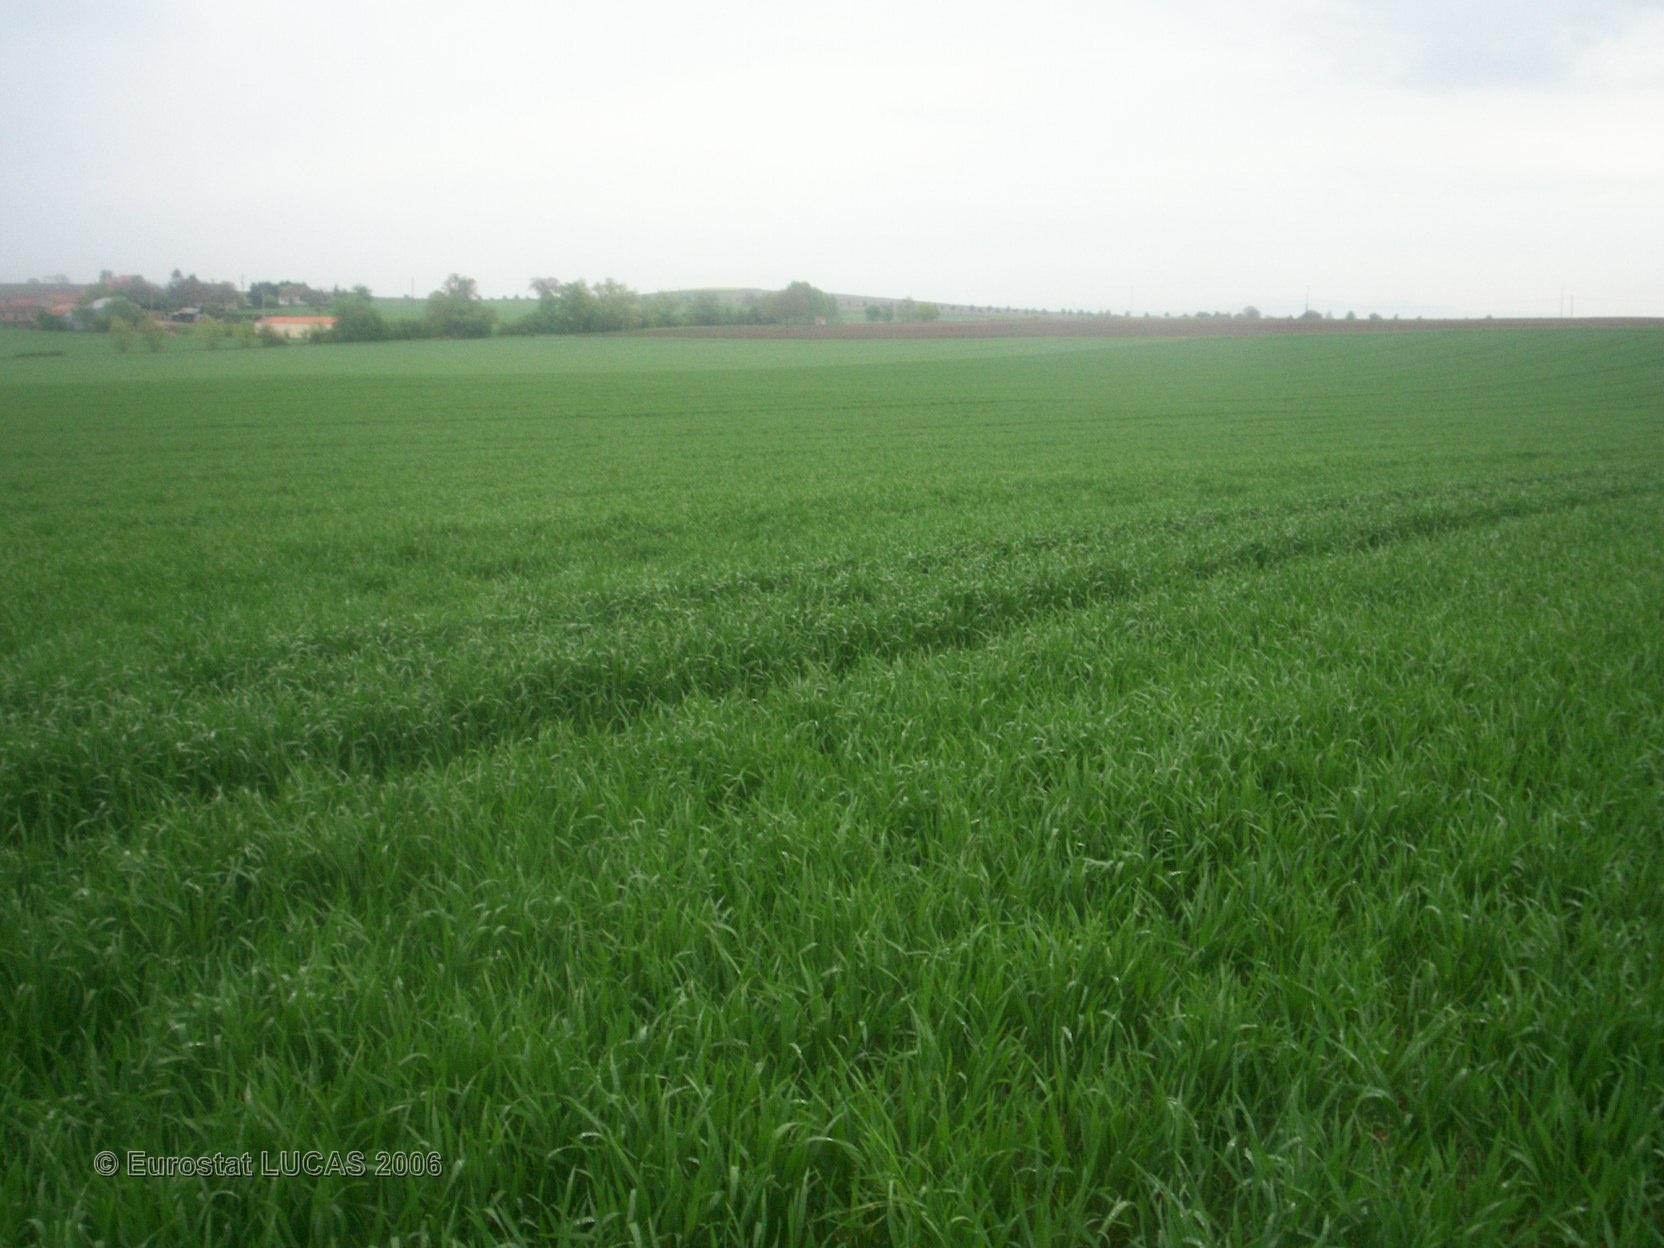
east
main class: Cropland
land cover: Rye
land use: Agriculture (excluding fallow land and kitchen gardens)
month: May
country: FR
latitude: 45.9882
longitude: 3.1701
